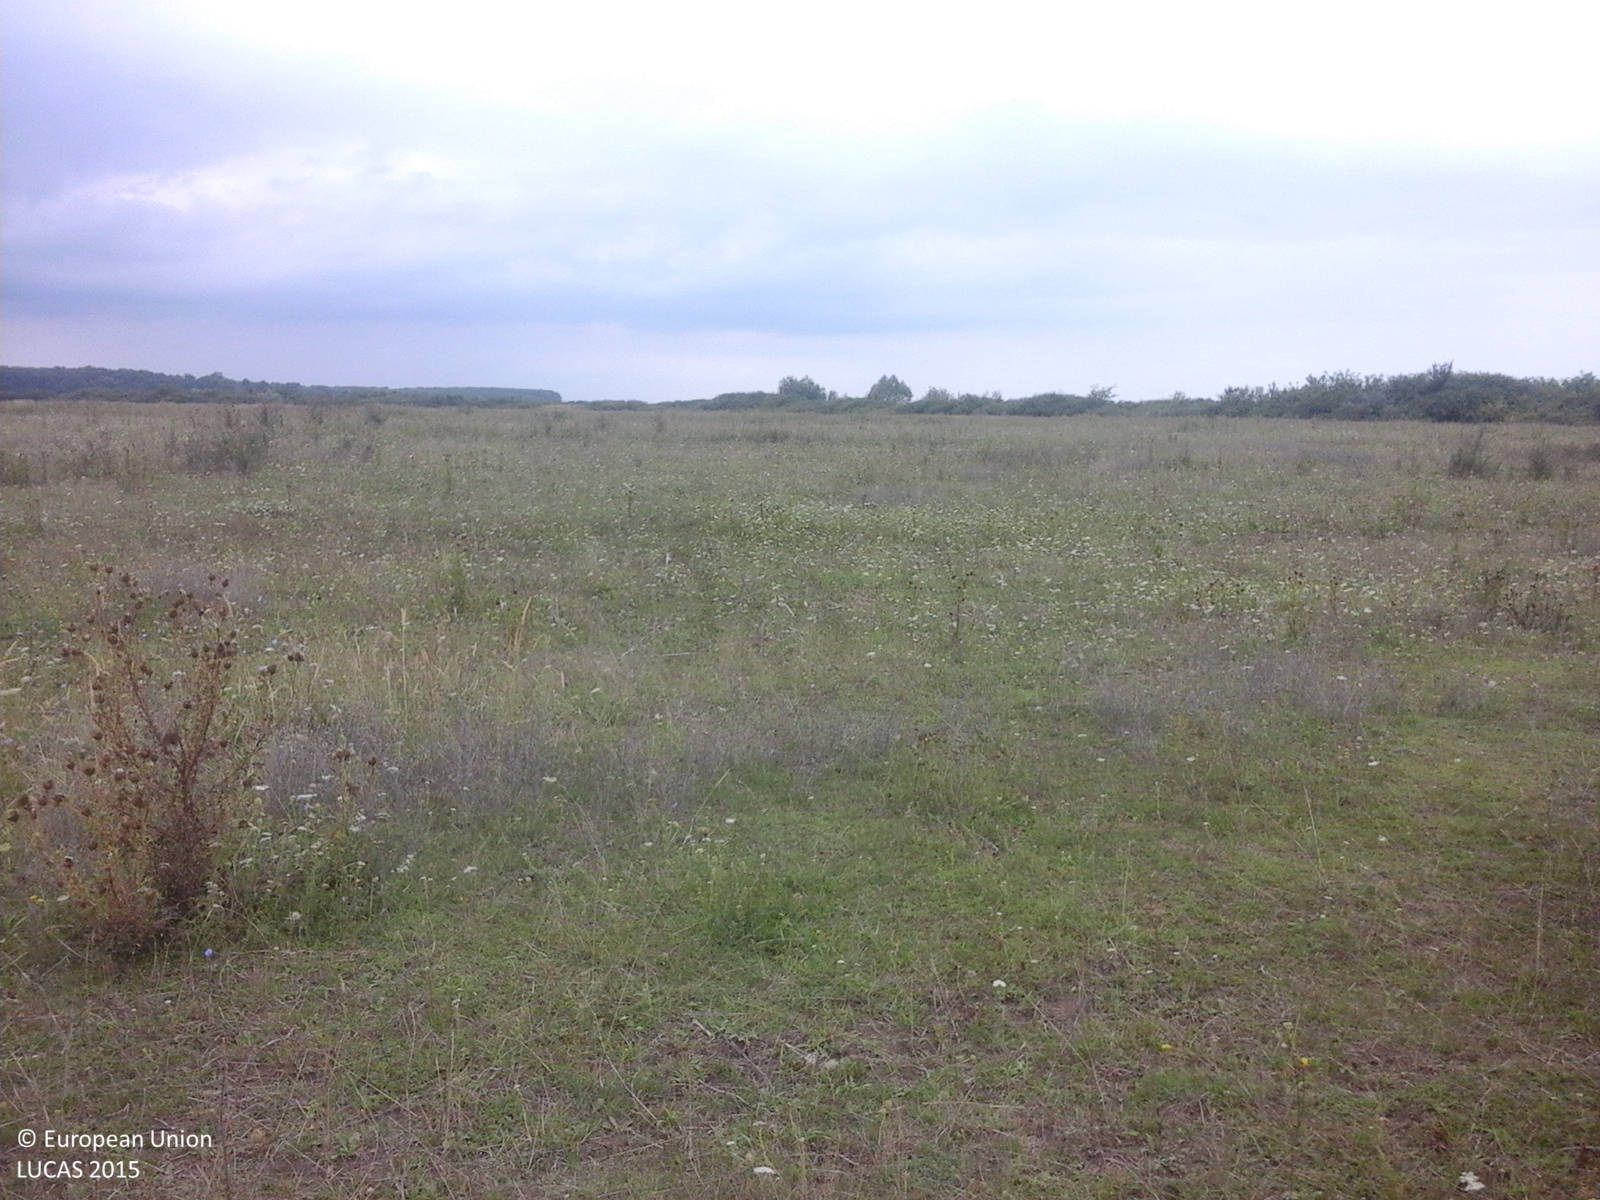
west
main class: Grassland
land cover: Grassland with sparse tree/shrub cover
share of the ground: > 75 %
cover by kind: herbaceous plants 85 %, shrubs 10 %, broadleaved forest trees 5 %
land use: Agriculture (excluding fallow land and kitchen gardens)
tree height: < 5 m
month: August
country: RO
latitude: 45.5019
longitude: 21.0722
